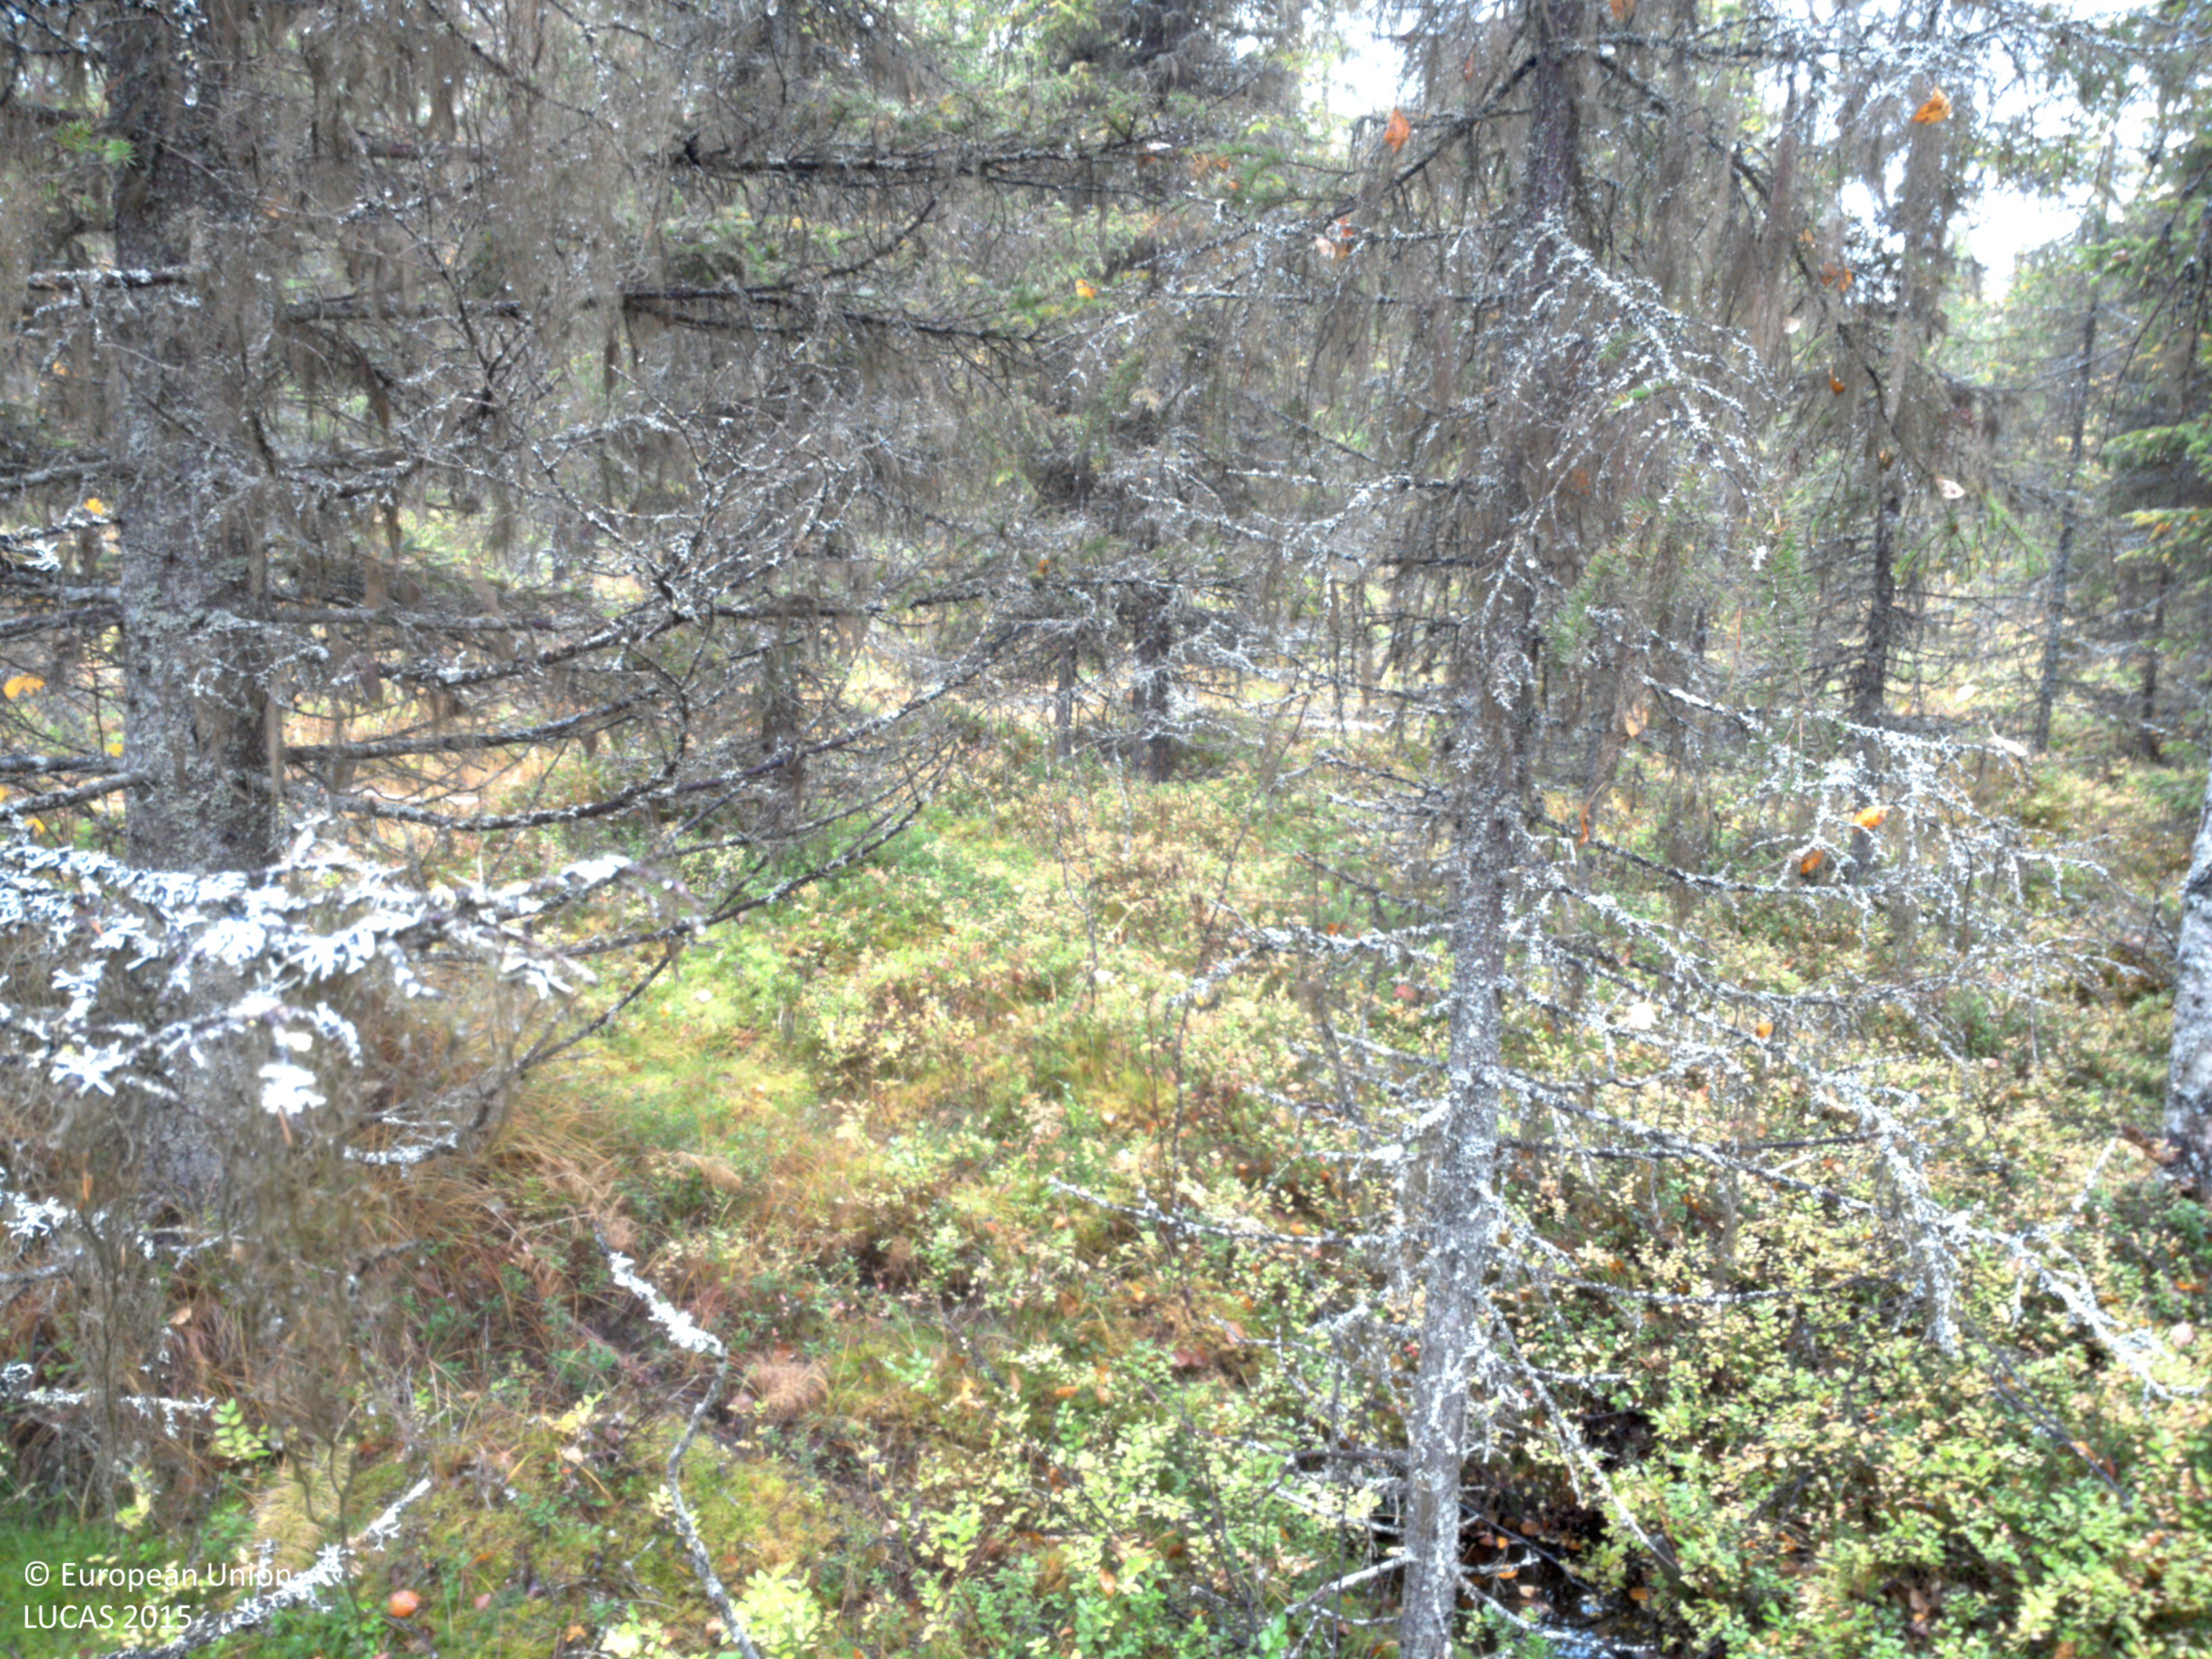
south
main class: Woodland
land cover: Spruce dominated mixed woodland
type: boreal forest
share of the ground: > 75 %
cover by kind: coniferous forest trees 55 %, broadleaved forest trees 25 %, shrubs 10 %, herbaceous plants 5 %, lichens and mosses 5 %
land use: Forestry
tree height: > 5 m
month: September
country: SE
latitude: 64.9967
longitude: 19.0196
